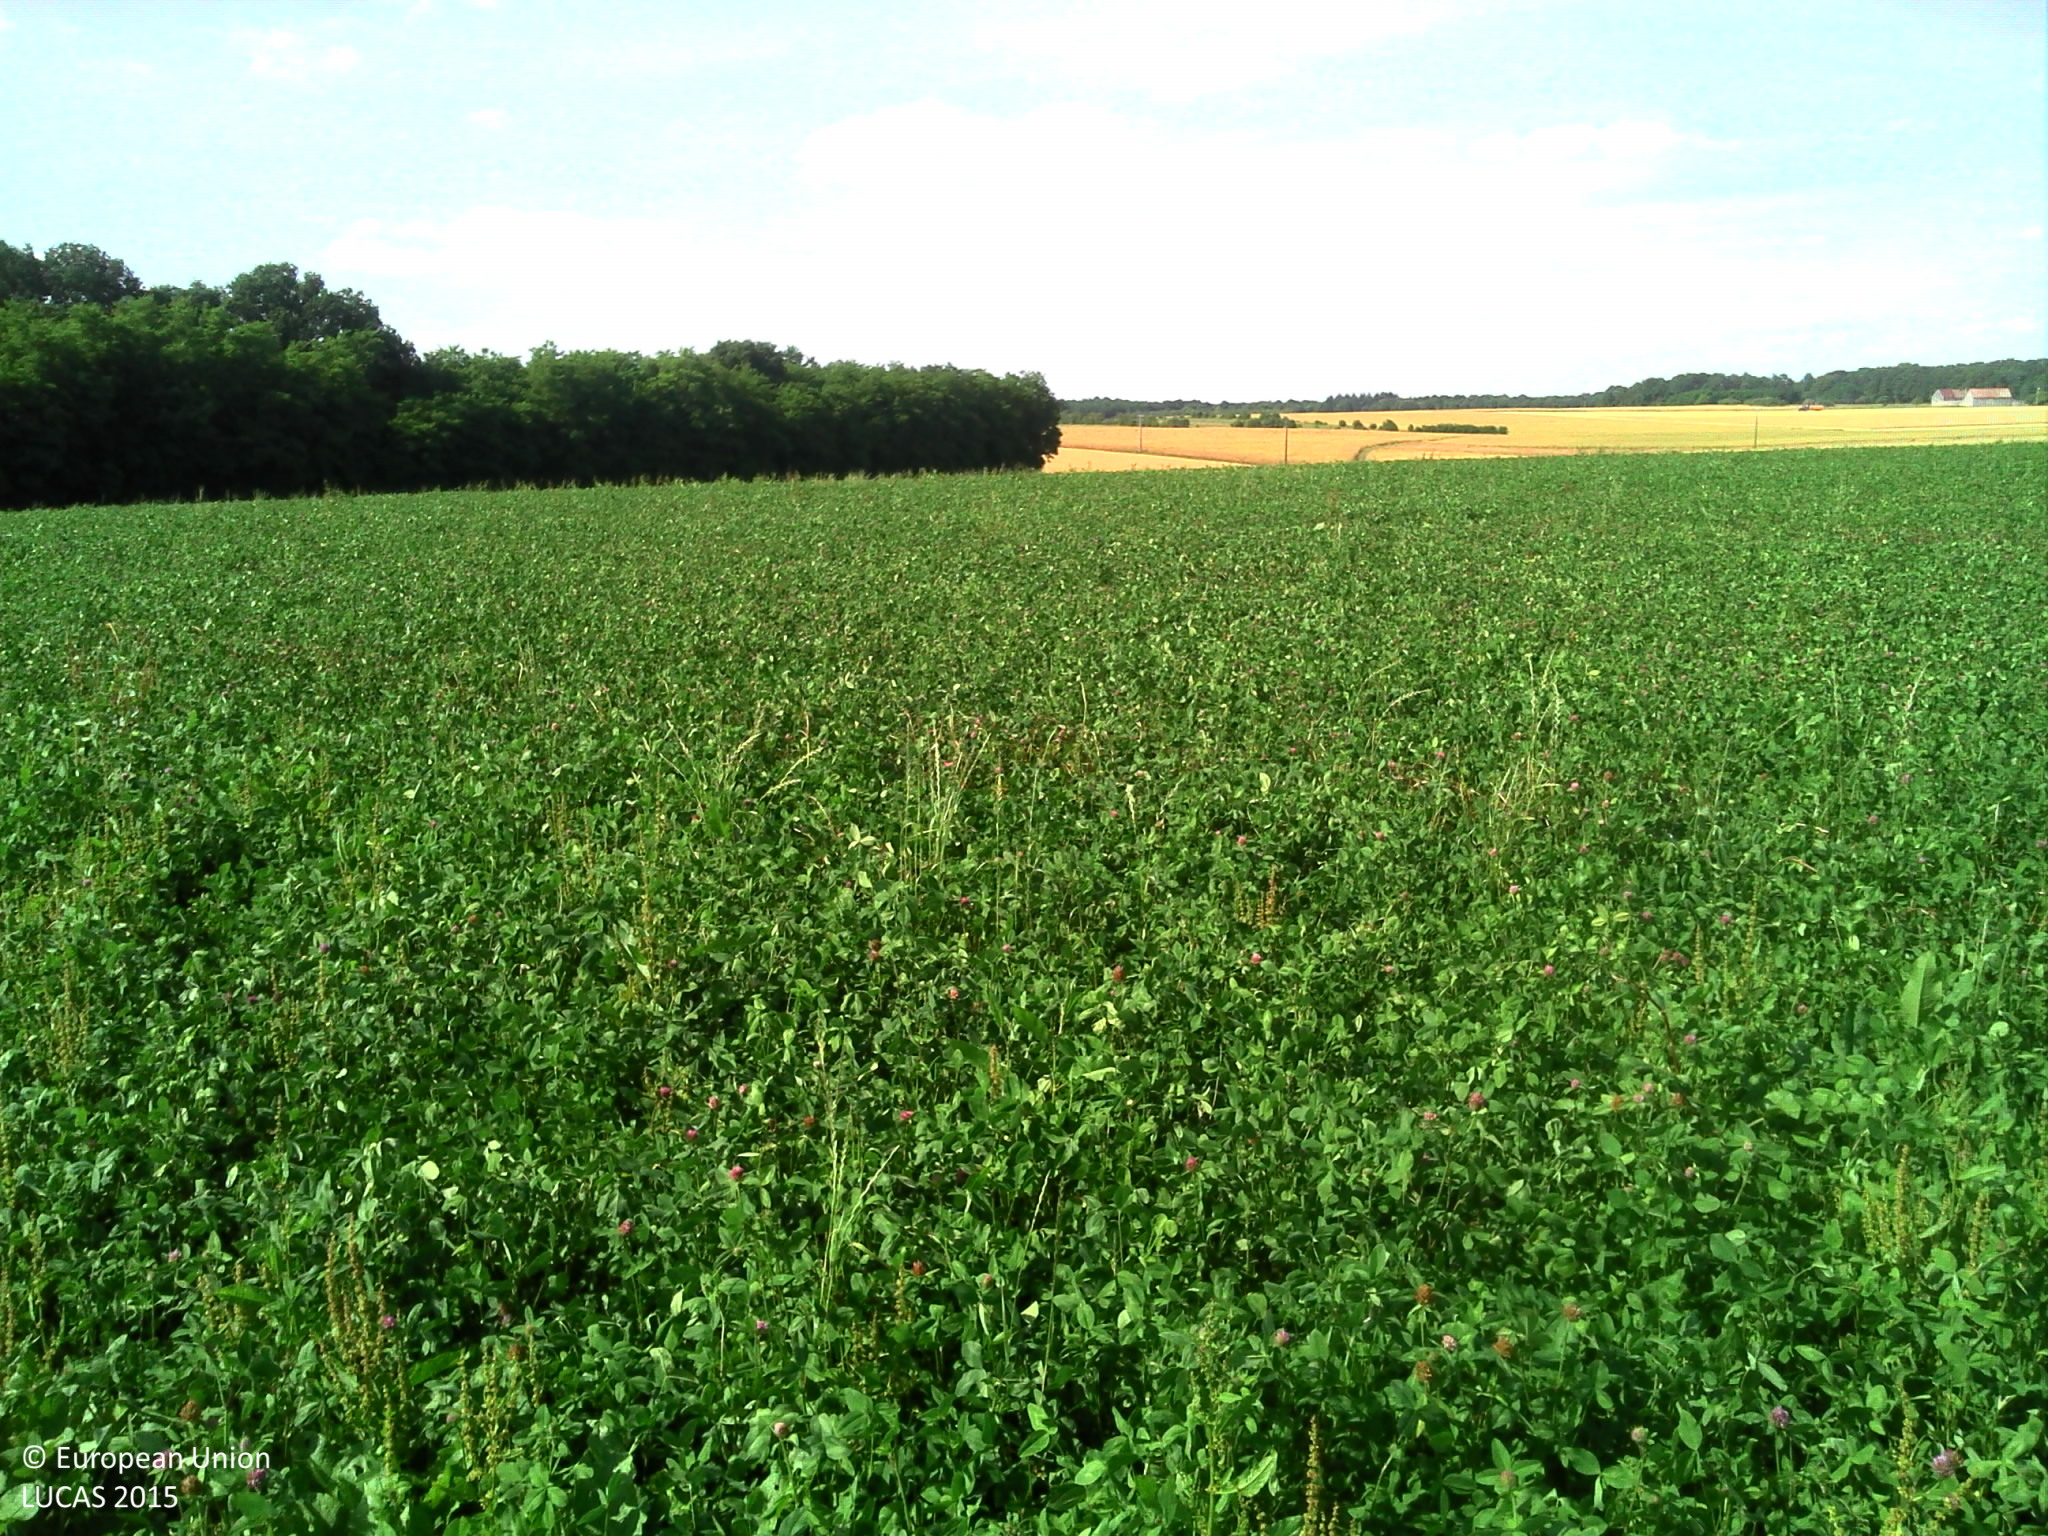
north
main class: Cropland
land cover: Clovers
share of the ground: > 75 %
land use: Agriculture (excluding fallow land and kitchen gardens)
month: June
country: FR
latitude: 48.0996
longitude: 3.4280
